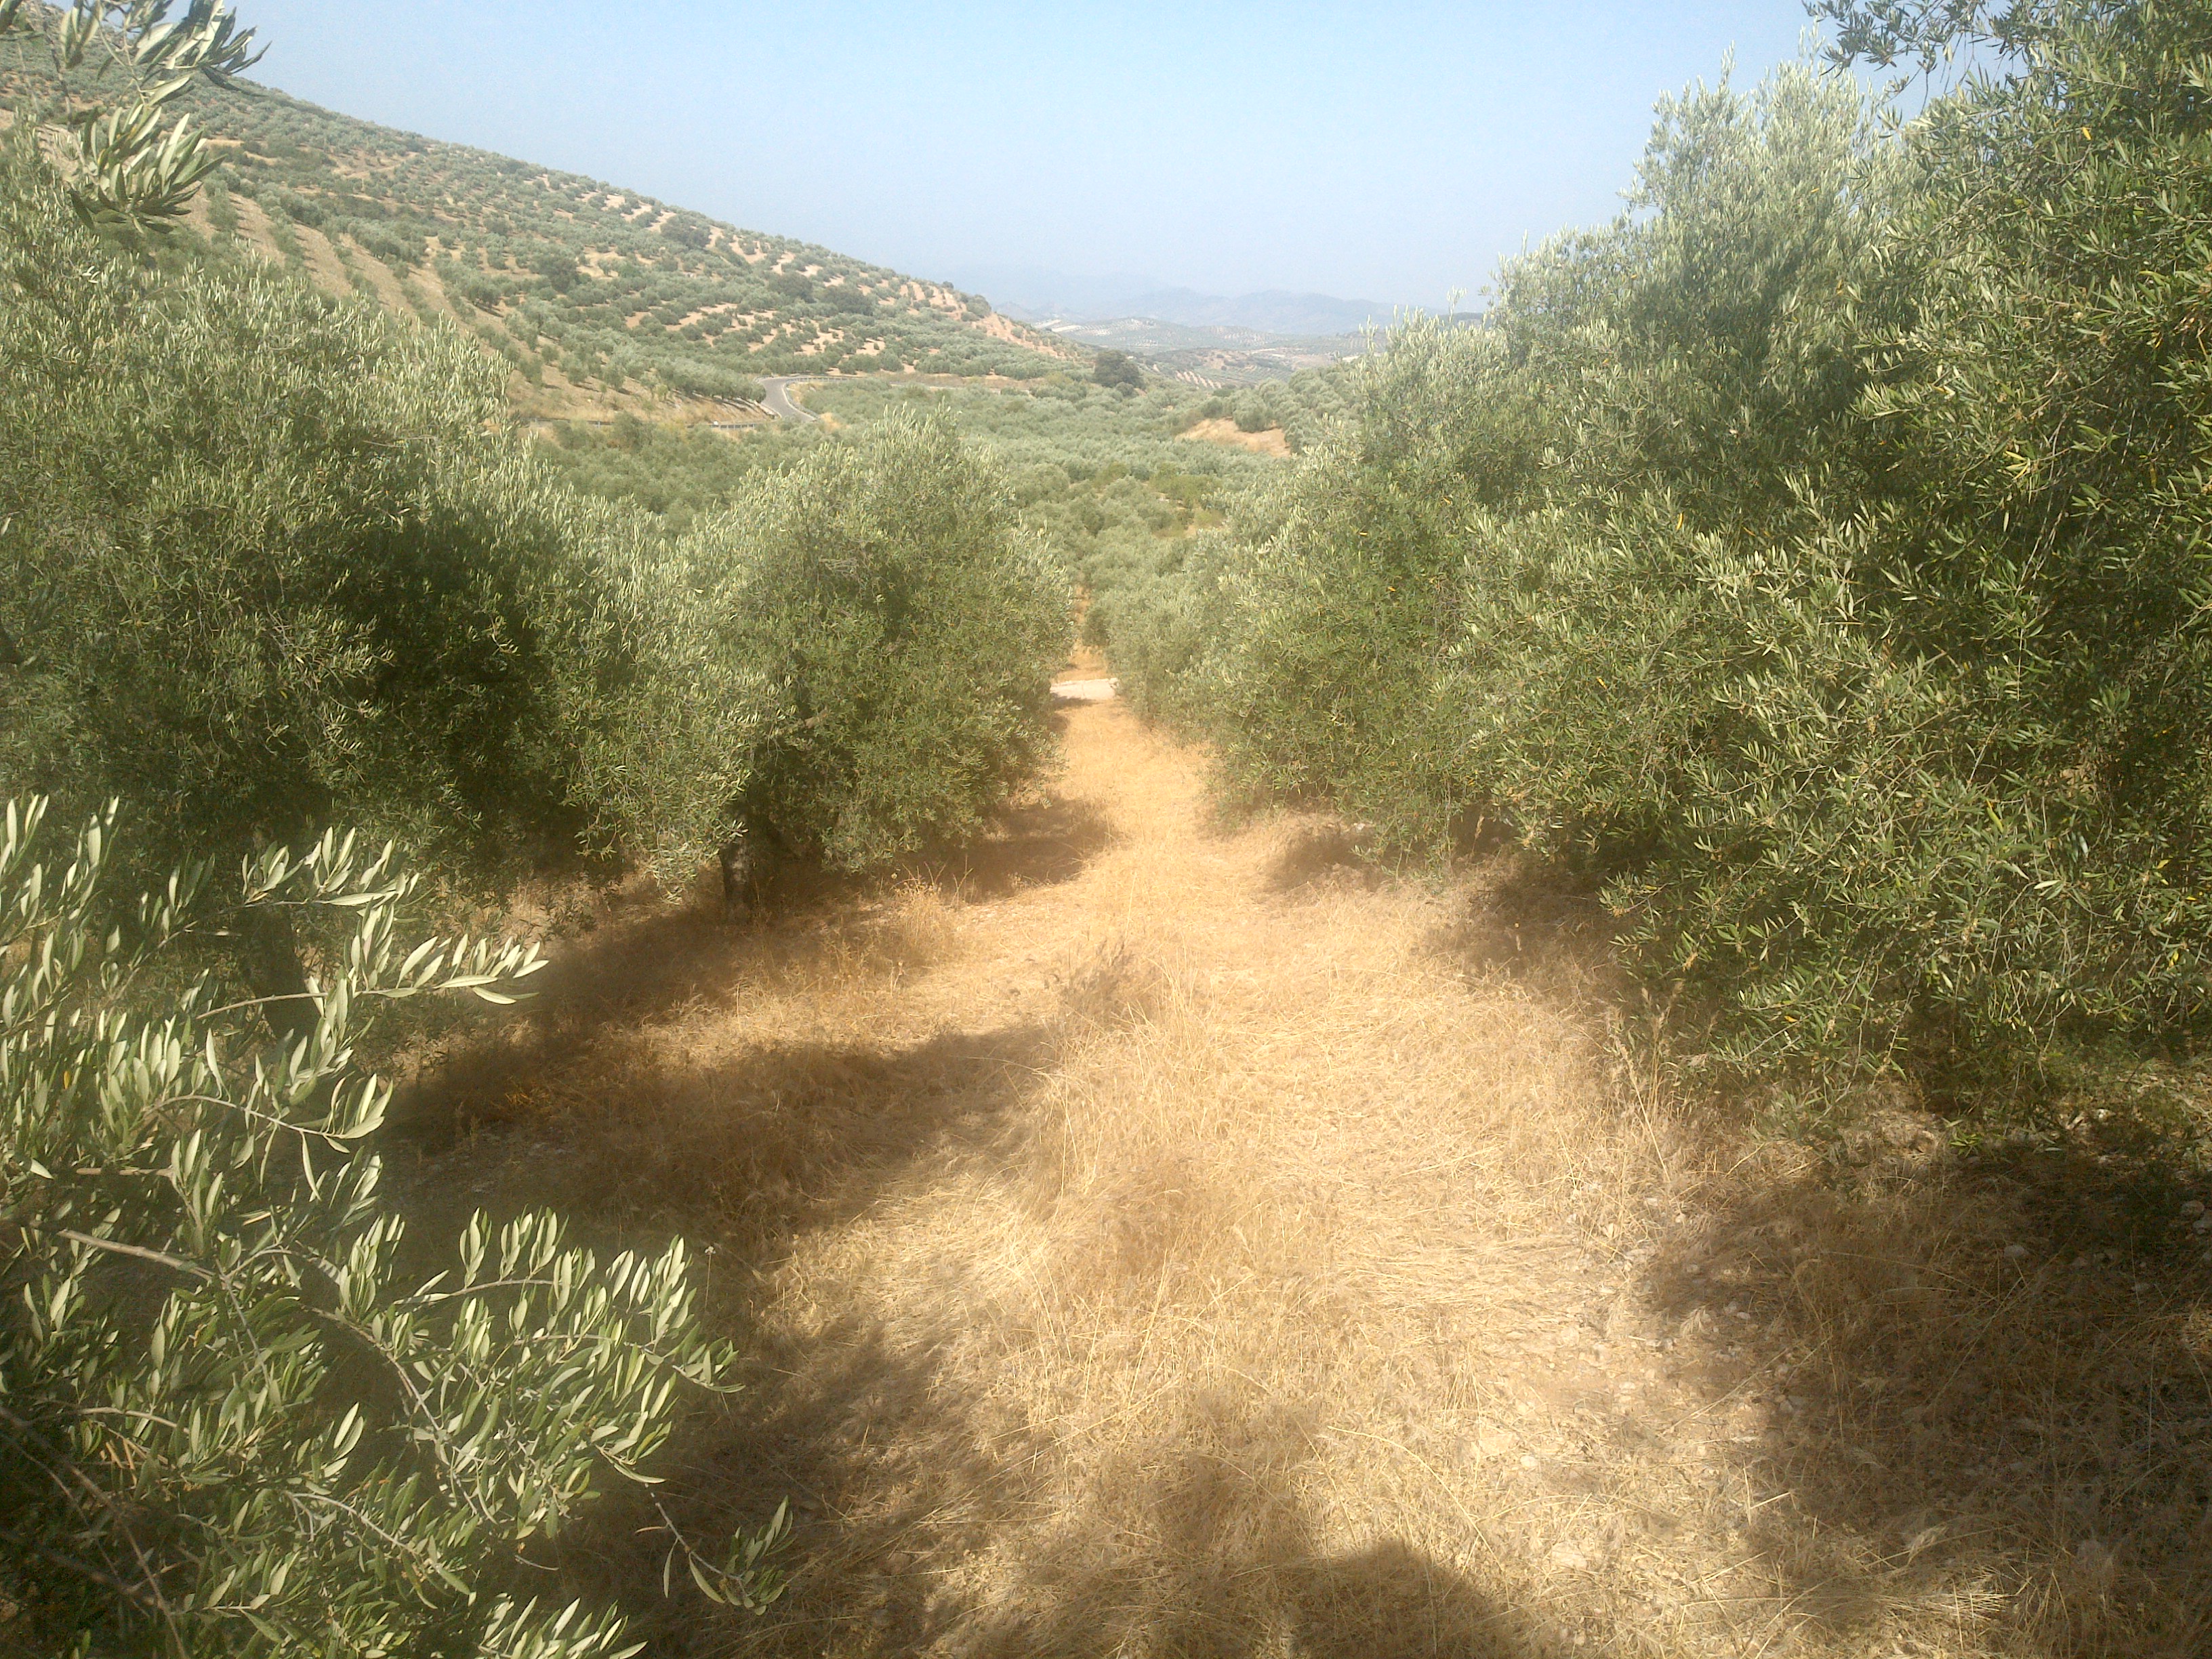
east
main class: Cropland
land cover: Olive groves
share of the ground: 50 - 75 %
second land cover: Spontaneously vegetated surfaces
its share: 25 - 50 %
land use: Agriculture (excluding fallow land and kitchen gardens)
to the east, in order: Olive groves; Spontaneously vegetated surfaces; Tracks; Olive groves; Grass margins; Rivers and streams; Grass margins; Olive groves
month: June
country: ES
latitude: 37.5179
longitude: -4.2233
